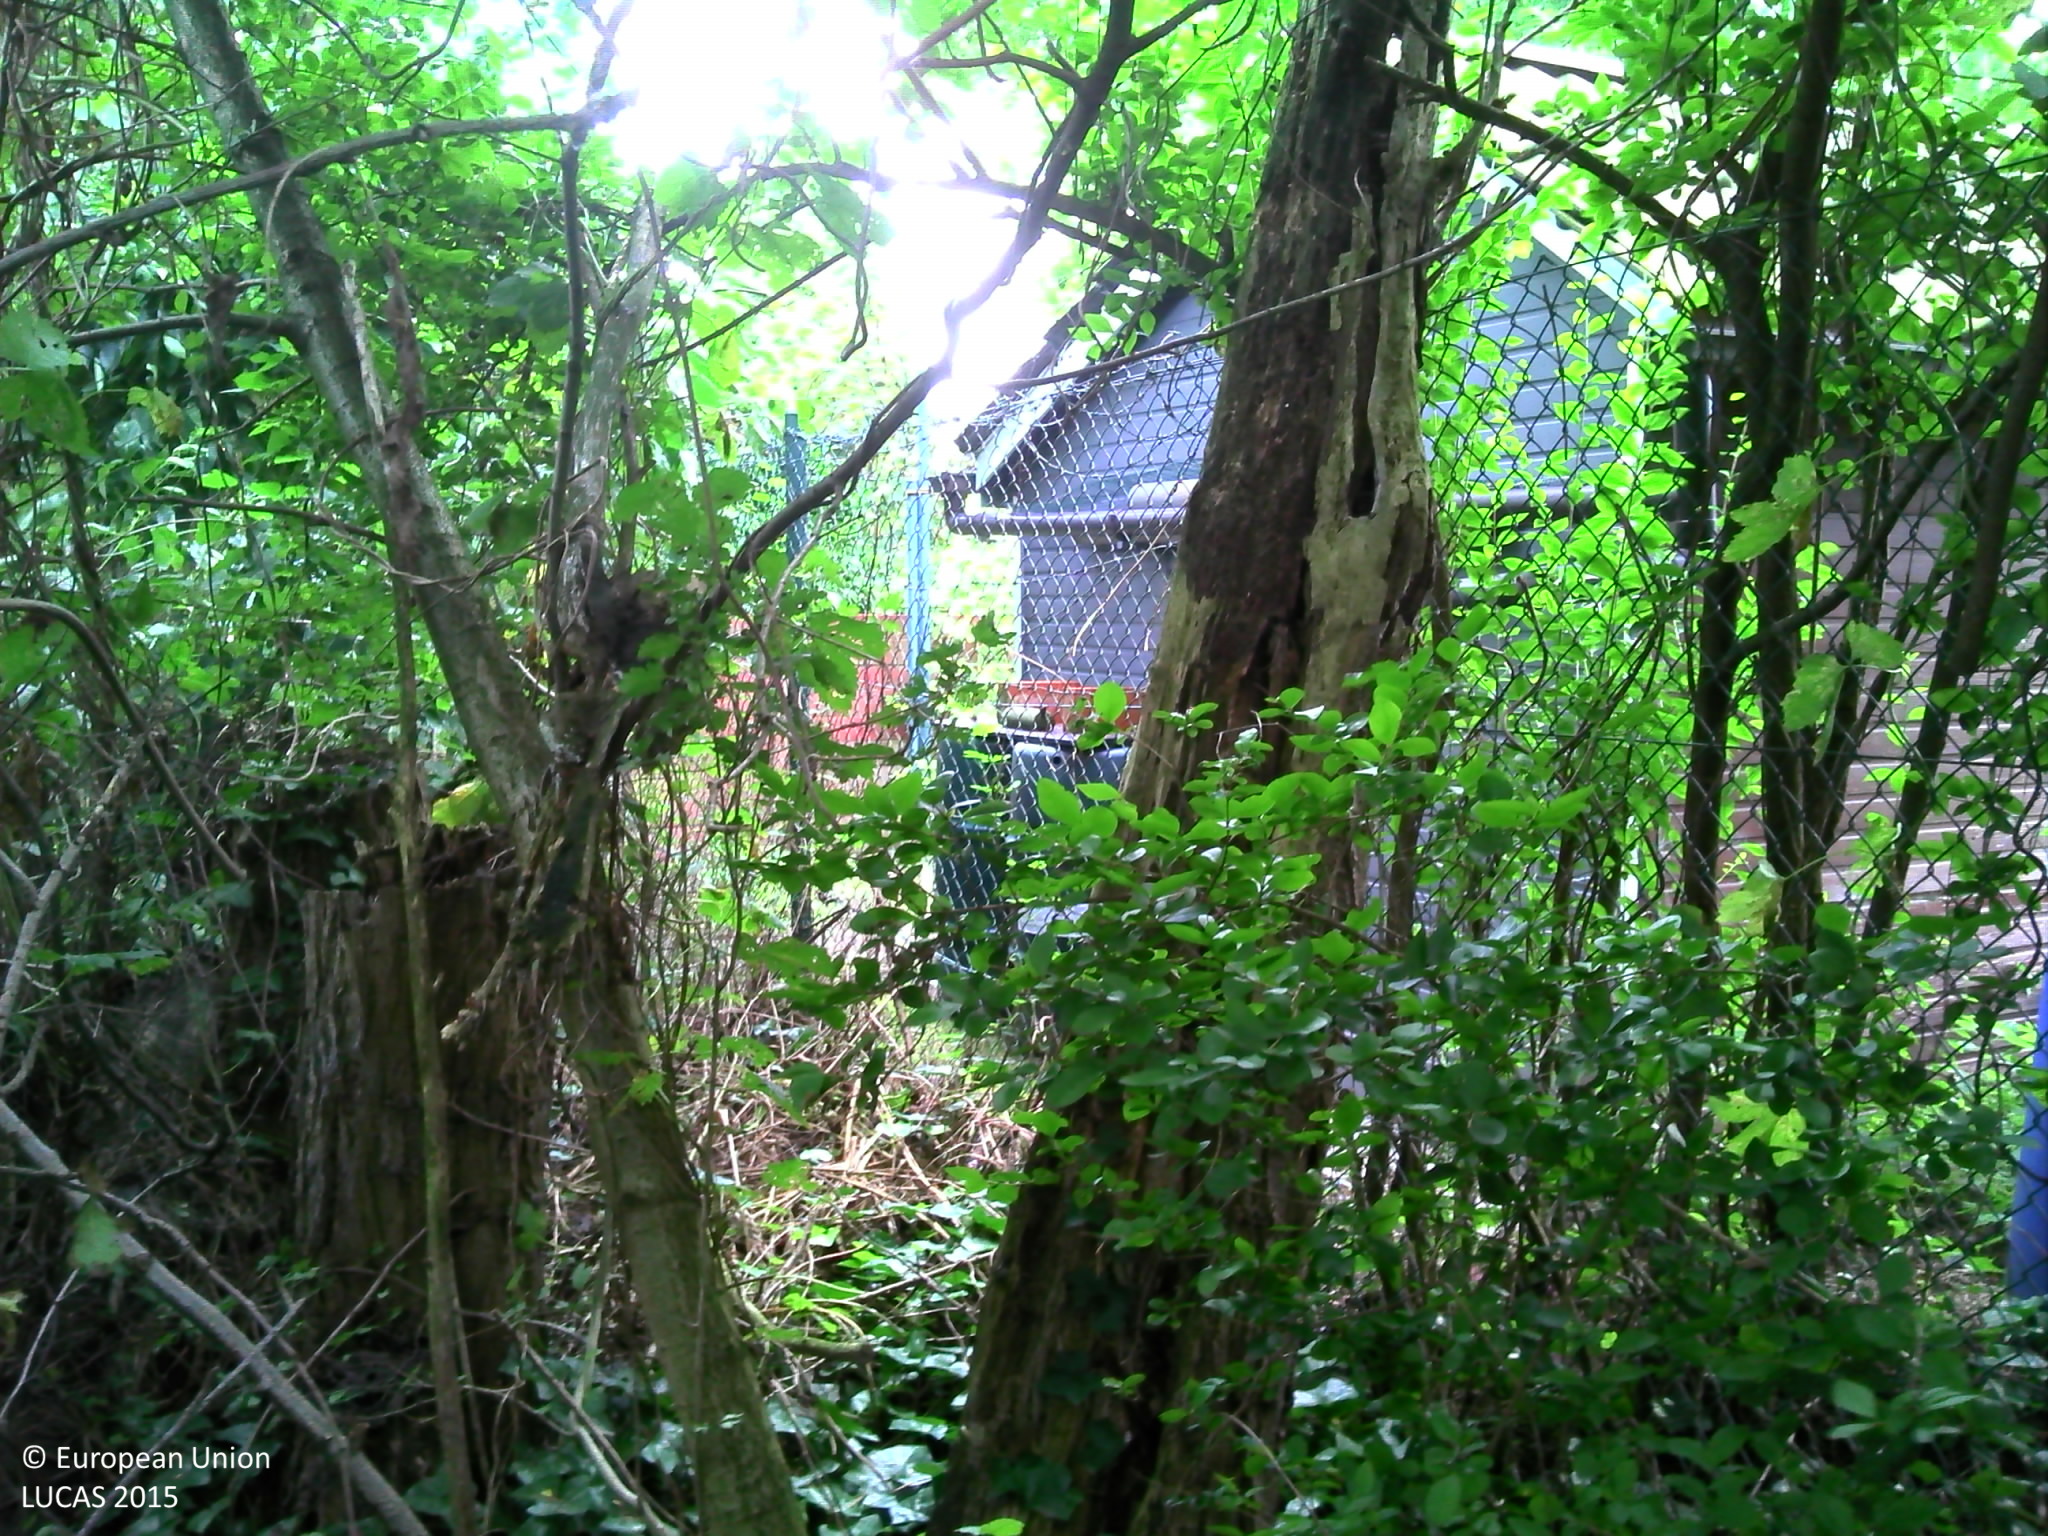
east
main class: Woodland
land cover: Broadleaved woodland
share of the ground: > 75 %
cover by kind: broadleaved forest trees 65 %, shrubs 15 %, coniferous forest trees 10 %, herbaceous plants 10 %
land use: Semi-natural and natural areas not in use
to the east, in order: Broadleaved woodland; Artificial constructions in urban areas
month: September
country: BE
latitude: 51.1616
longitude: 4.3470
